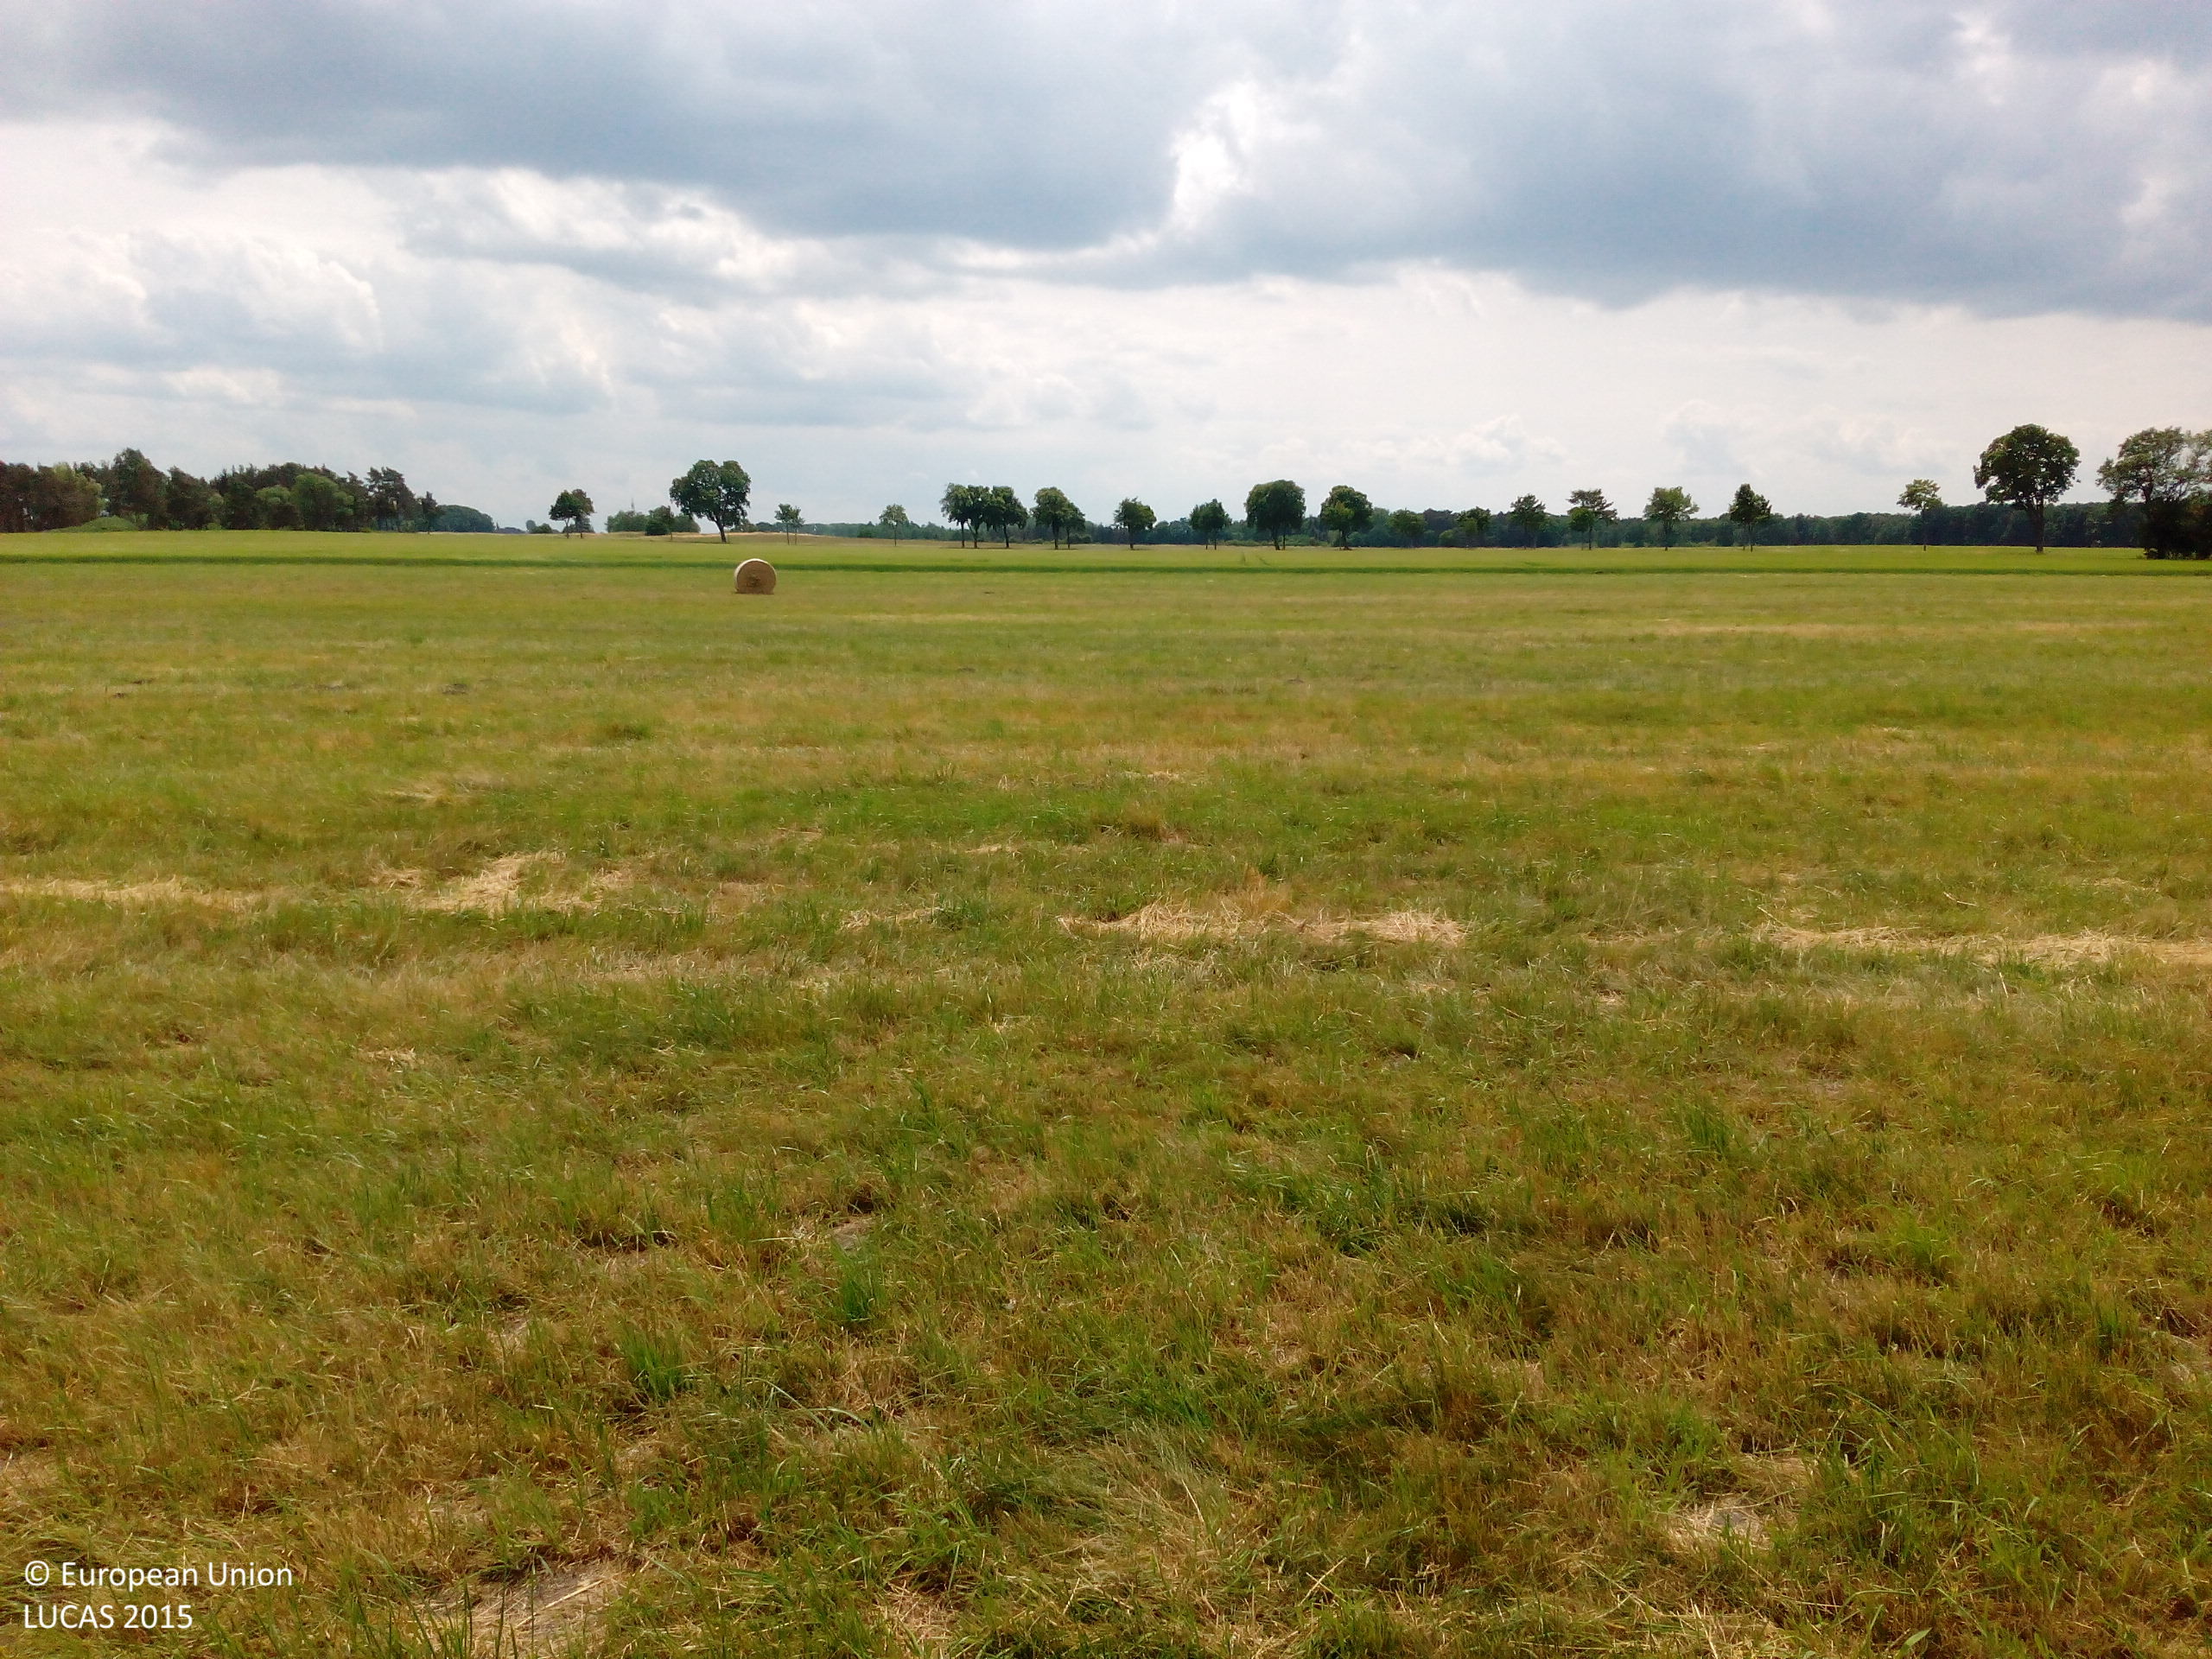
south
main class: Grassland
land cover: Grassland without tree/shrub cover
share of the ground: > 75 %
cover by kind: herbaceous plants 100 %
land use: Agriculture (excluding fallow land and kitchen gardens)
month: June
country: DE
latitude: 52.3771
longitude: 10.2790
